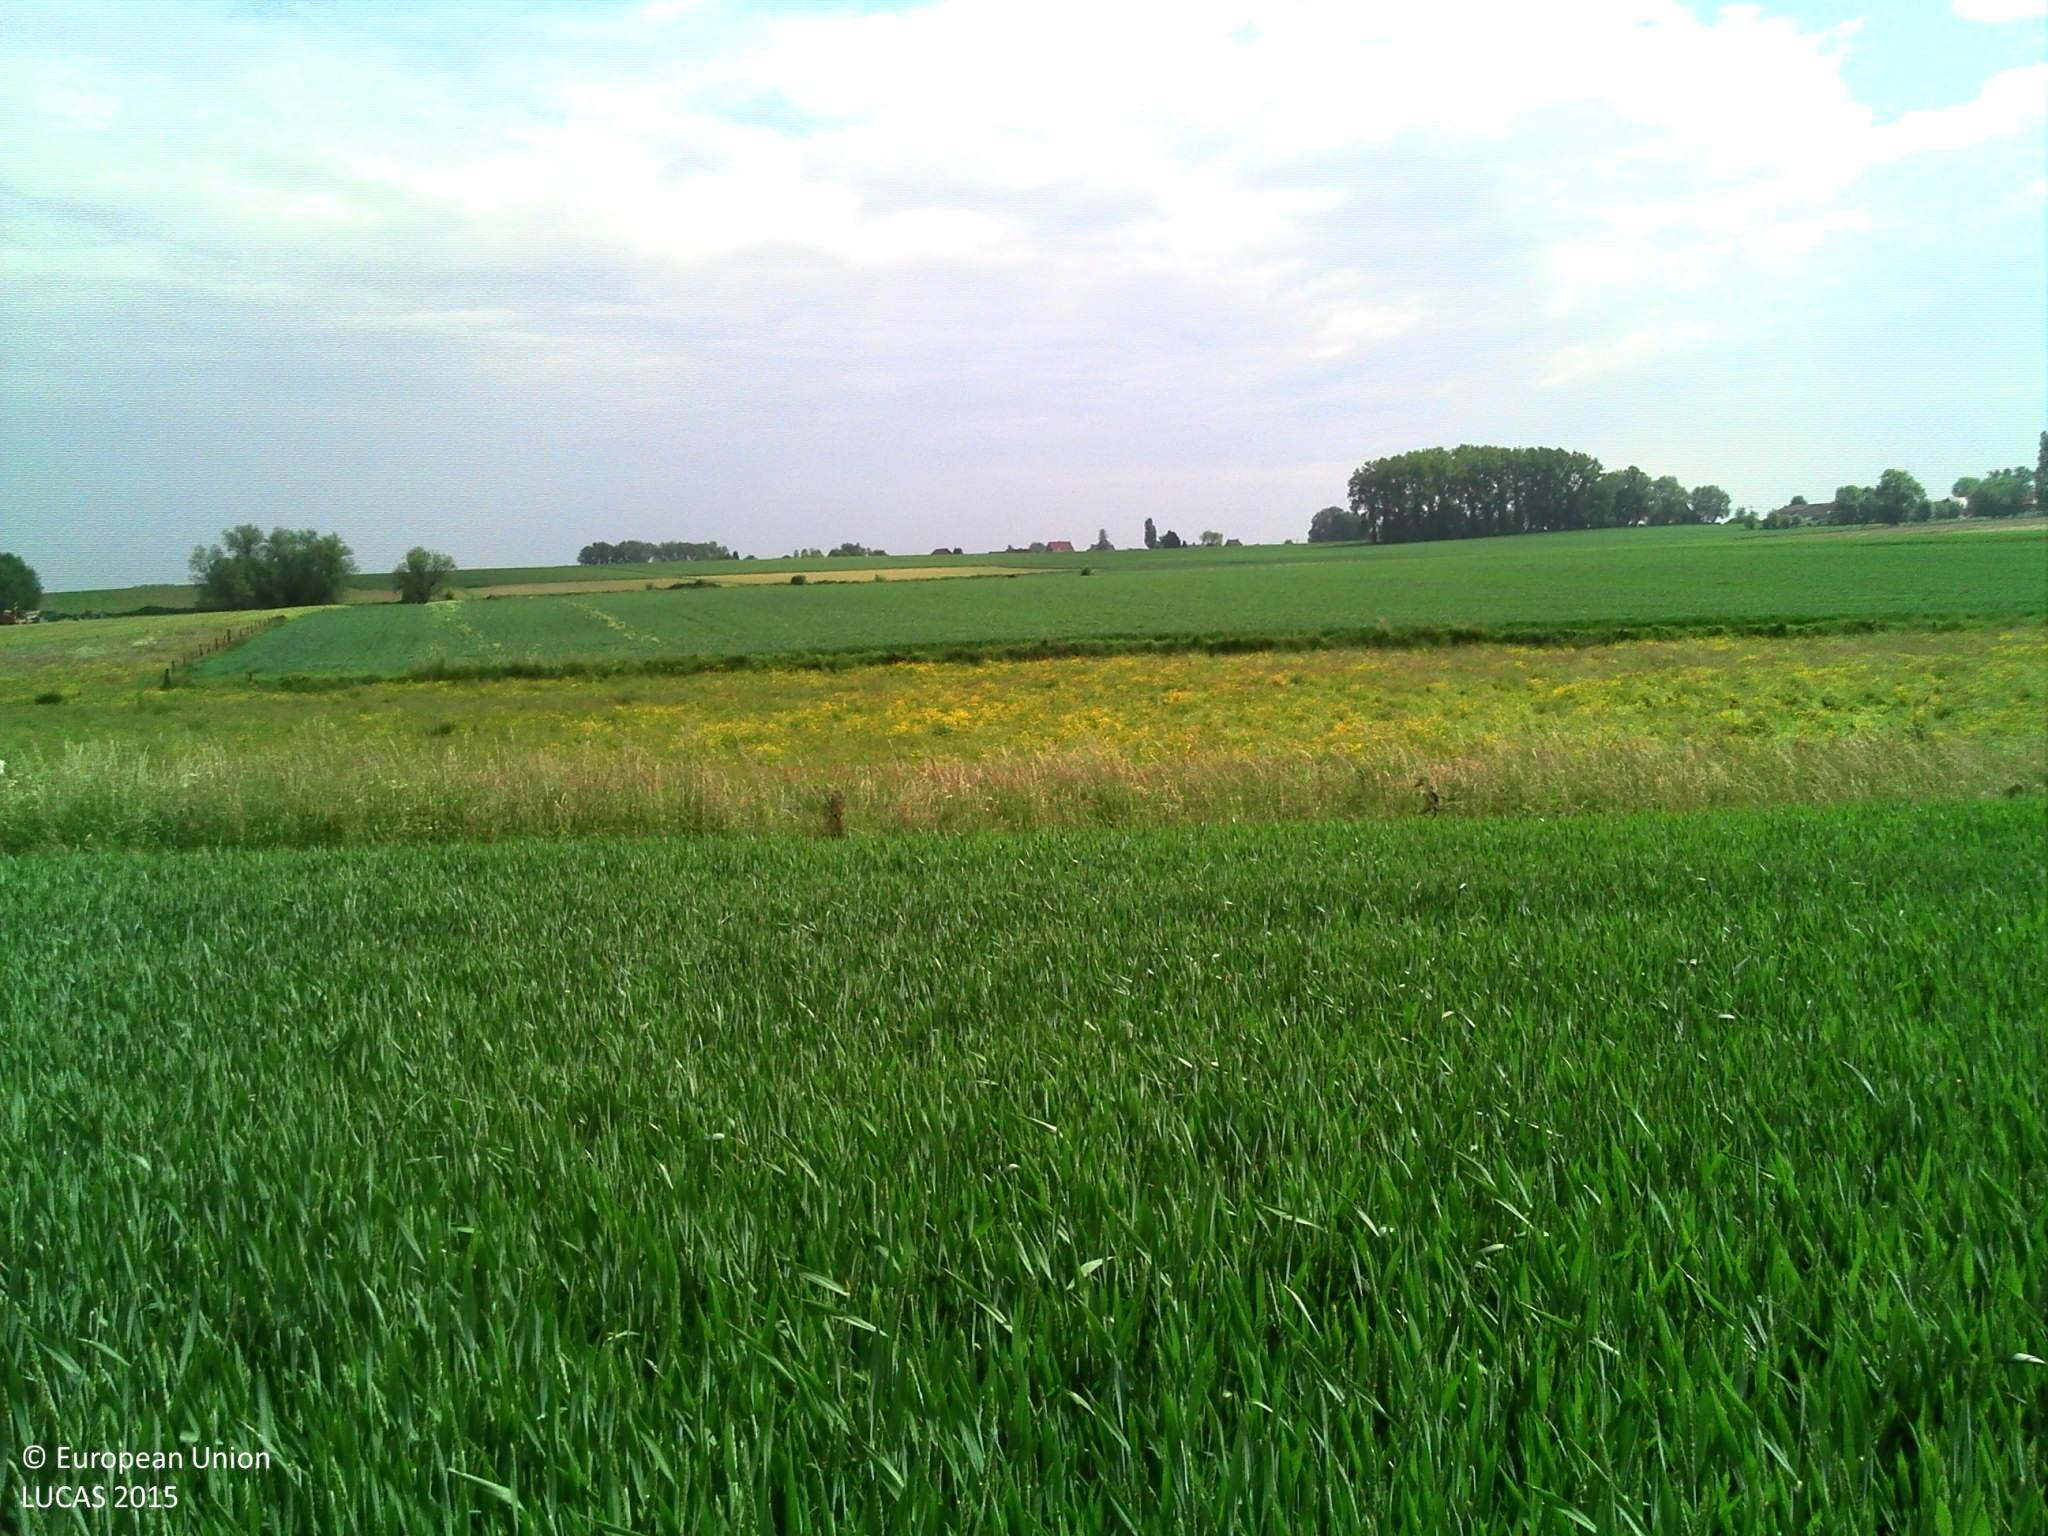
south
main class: Cropland
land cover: Common wheat
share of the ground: > 75 %
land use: Agriculture (excluding fallow land and kitchen gardens)
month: May
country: BE
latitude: 50.7116
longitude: 4.0037
